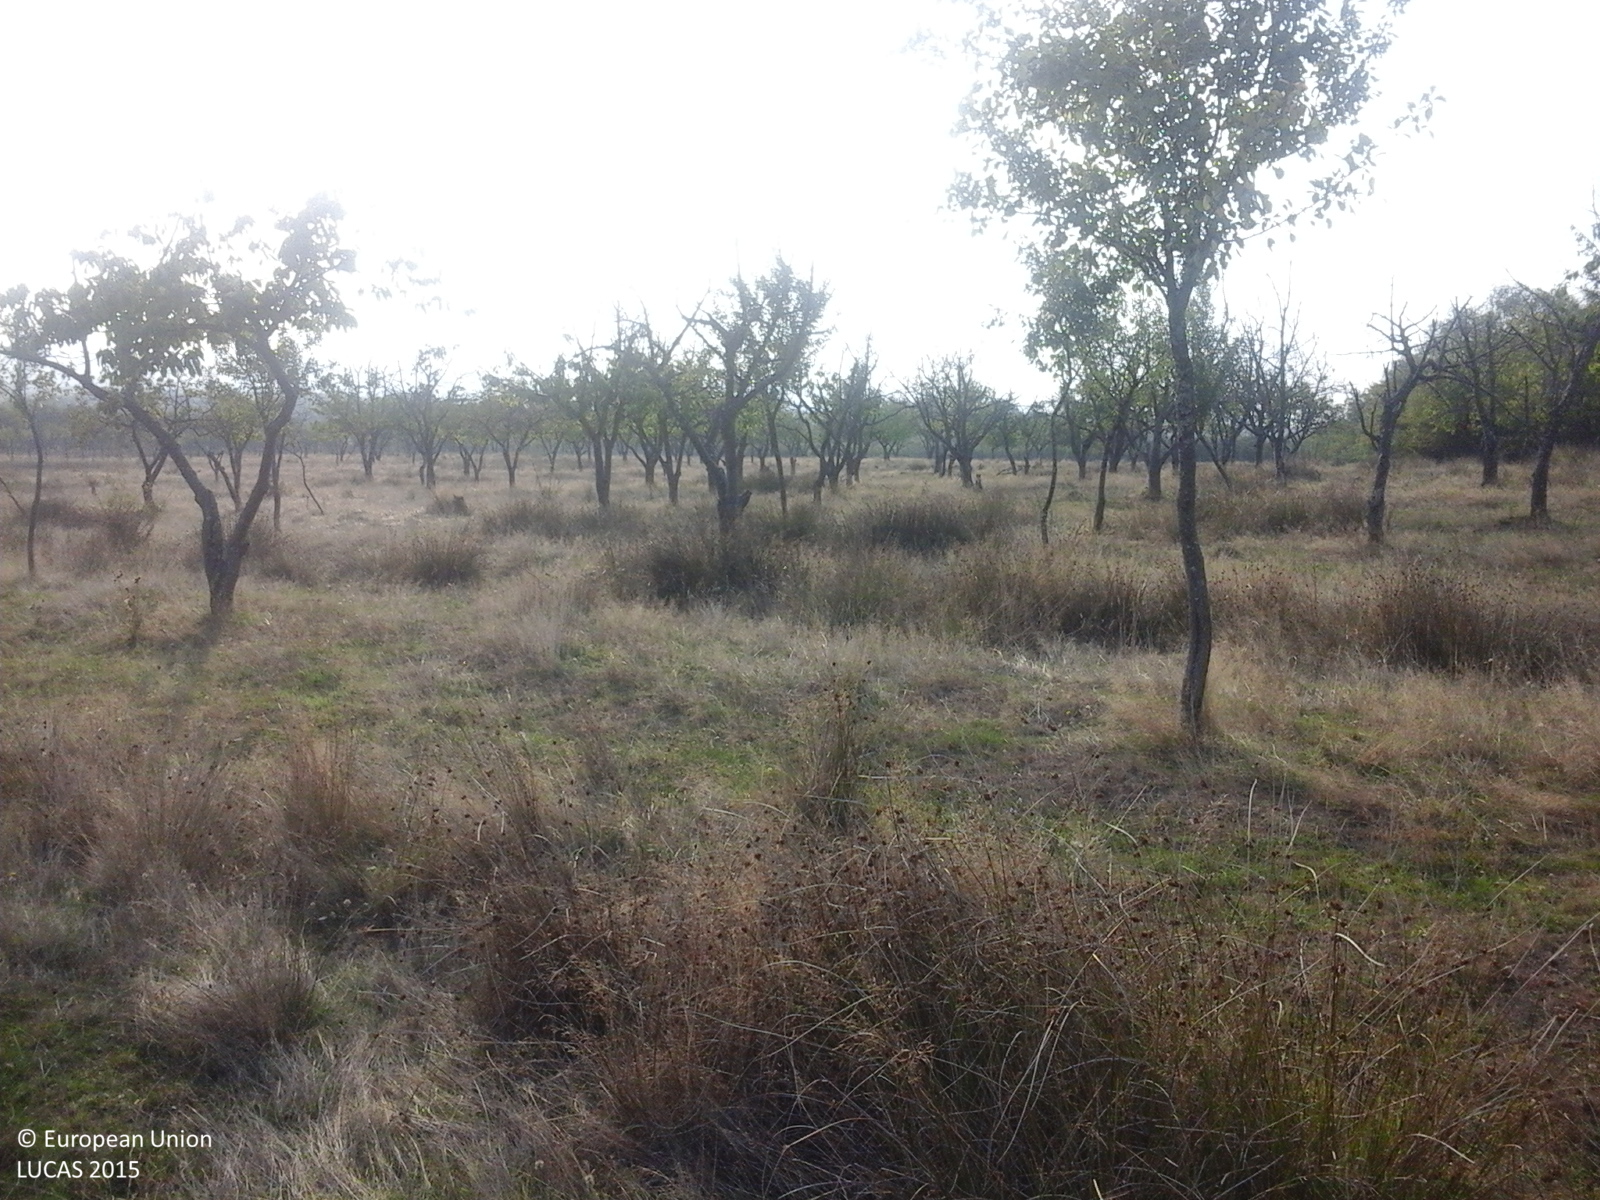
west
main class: Cropland
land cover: Cherry fruit
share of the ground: 50 - 75 %
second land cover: Grassland without tree/shrub cover
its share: > 75 %
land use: Agriculture (excluding fallow land and kitchen gardens)
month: September
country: RO
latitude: 45.5205
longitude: 22.2165
